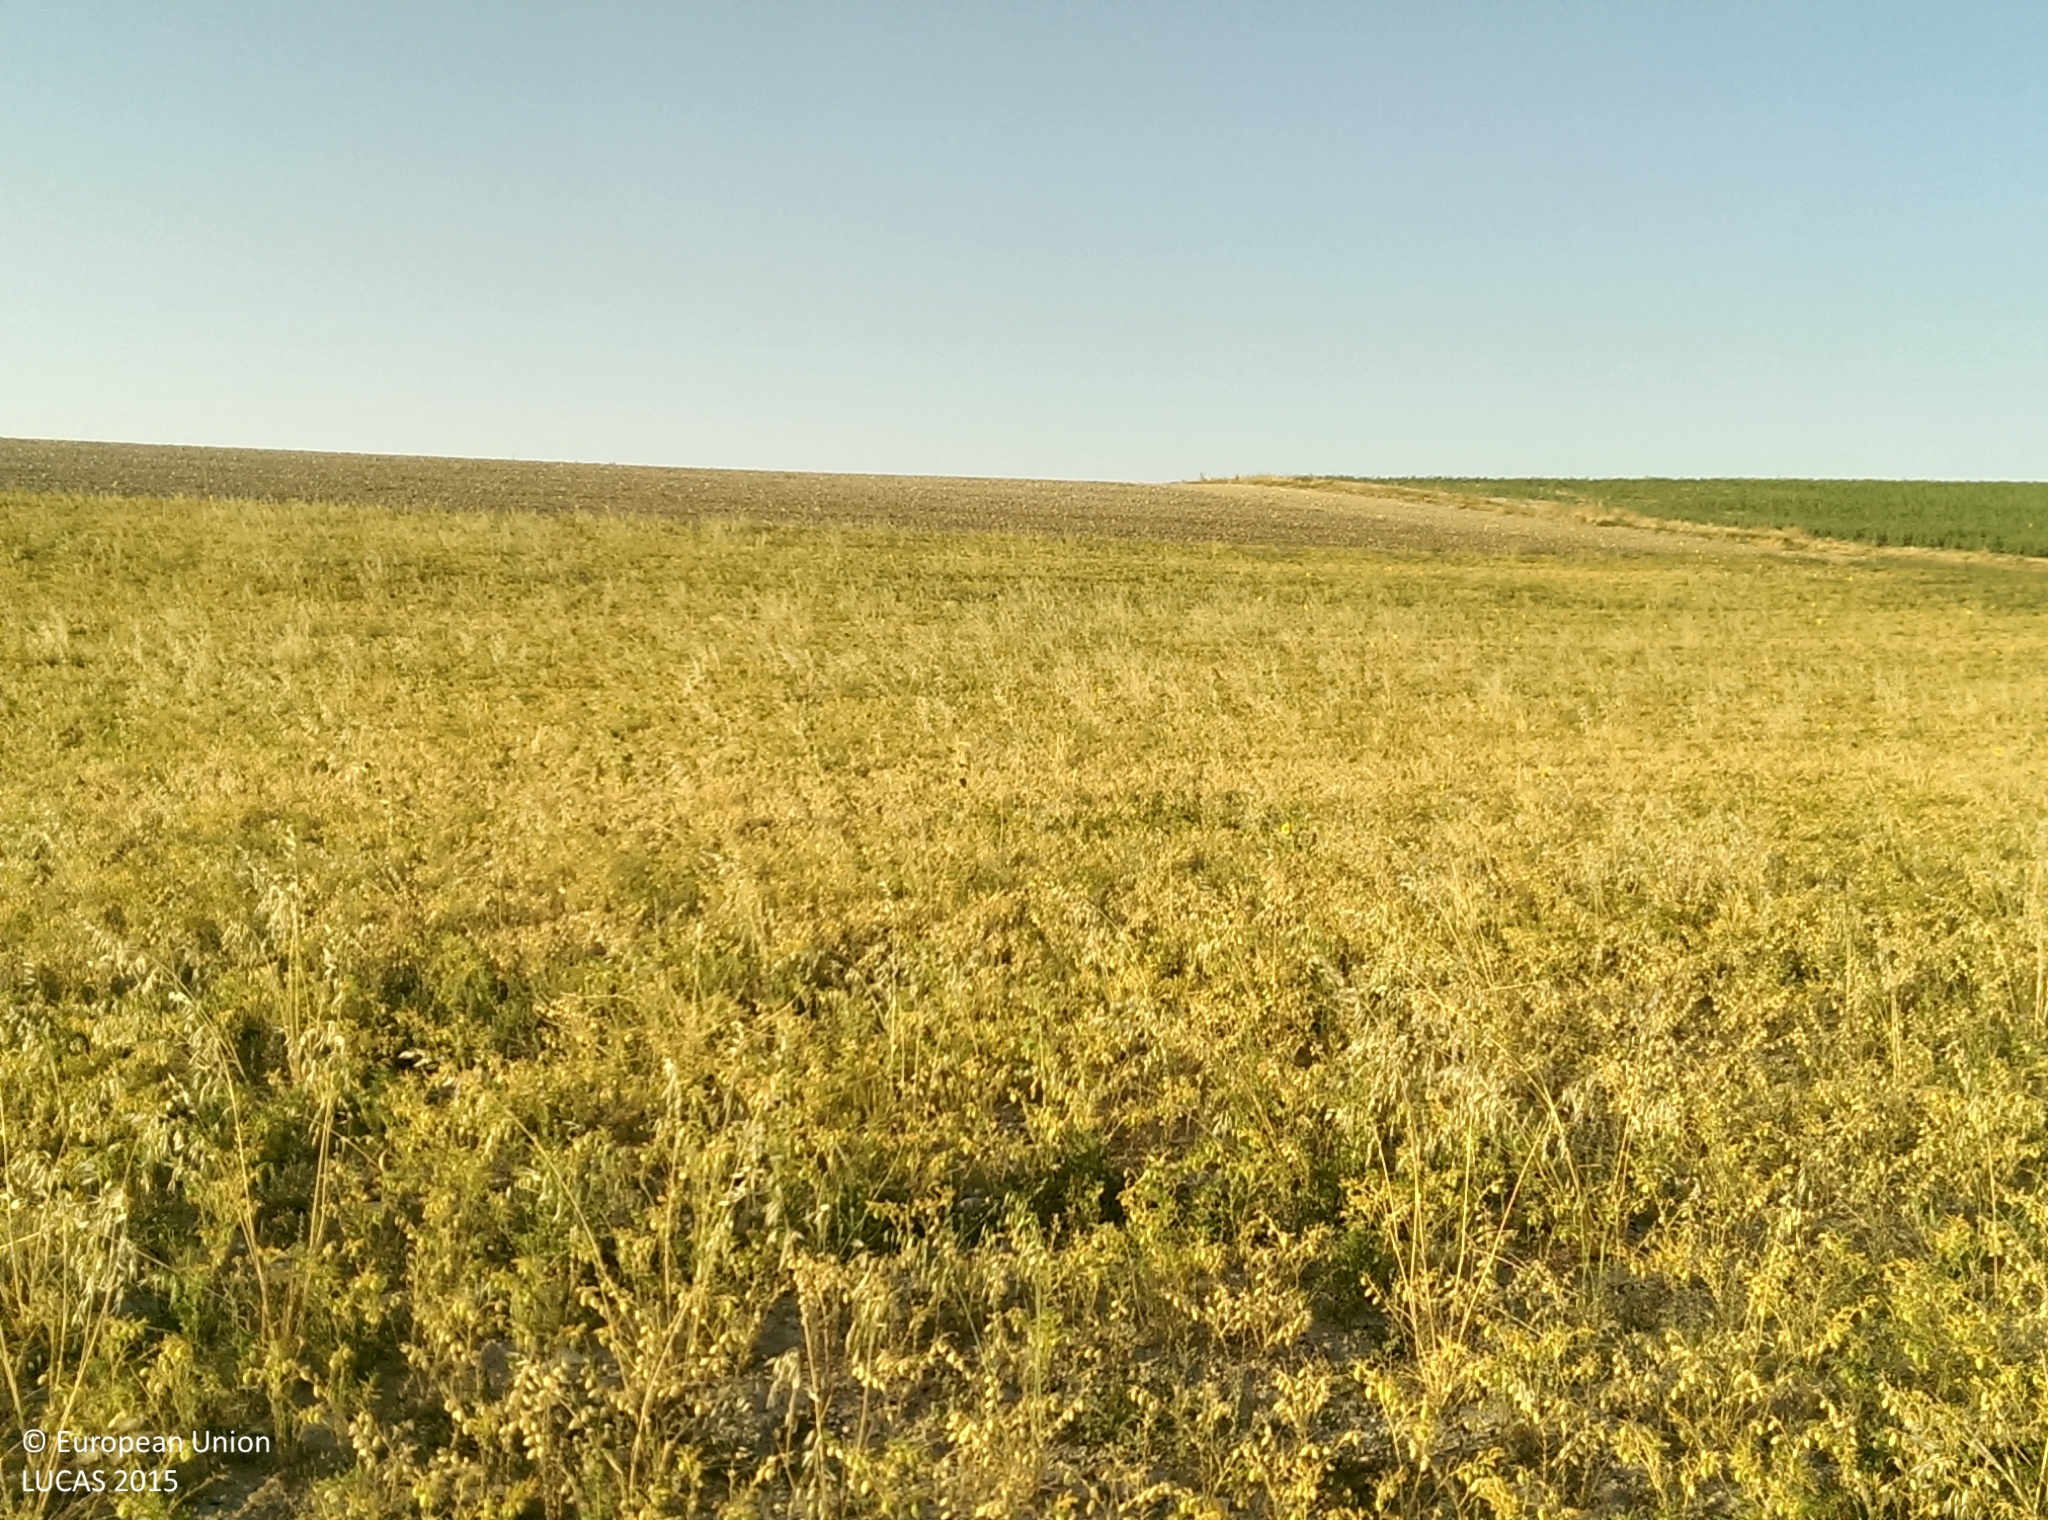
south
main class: Cropland
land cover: Dry pulses
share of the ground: > 75 %
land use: Agriculture (excluding fallow land and kitchen gardens)
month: July
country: ES
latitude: 37.5053
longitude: -3.3063
